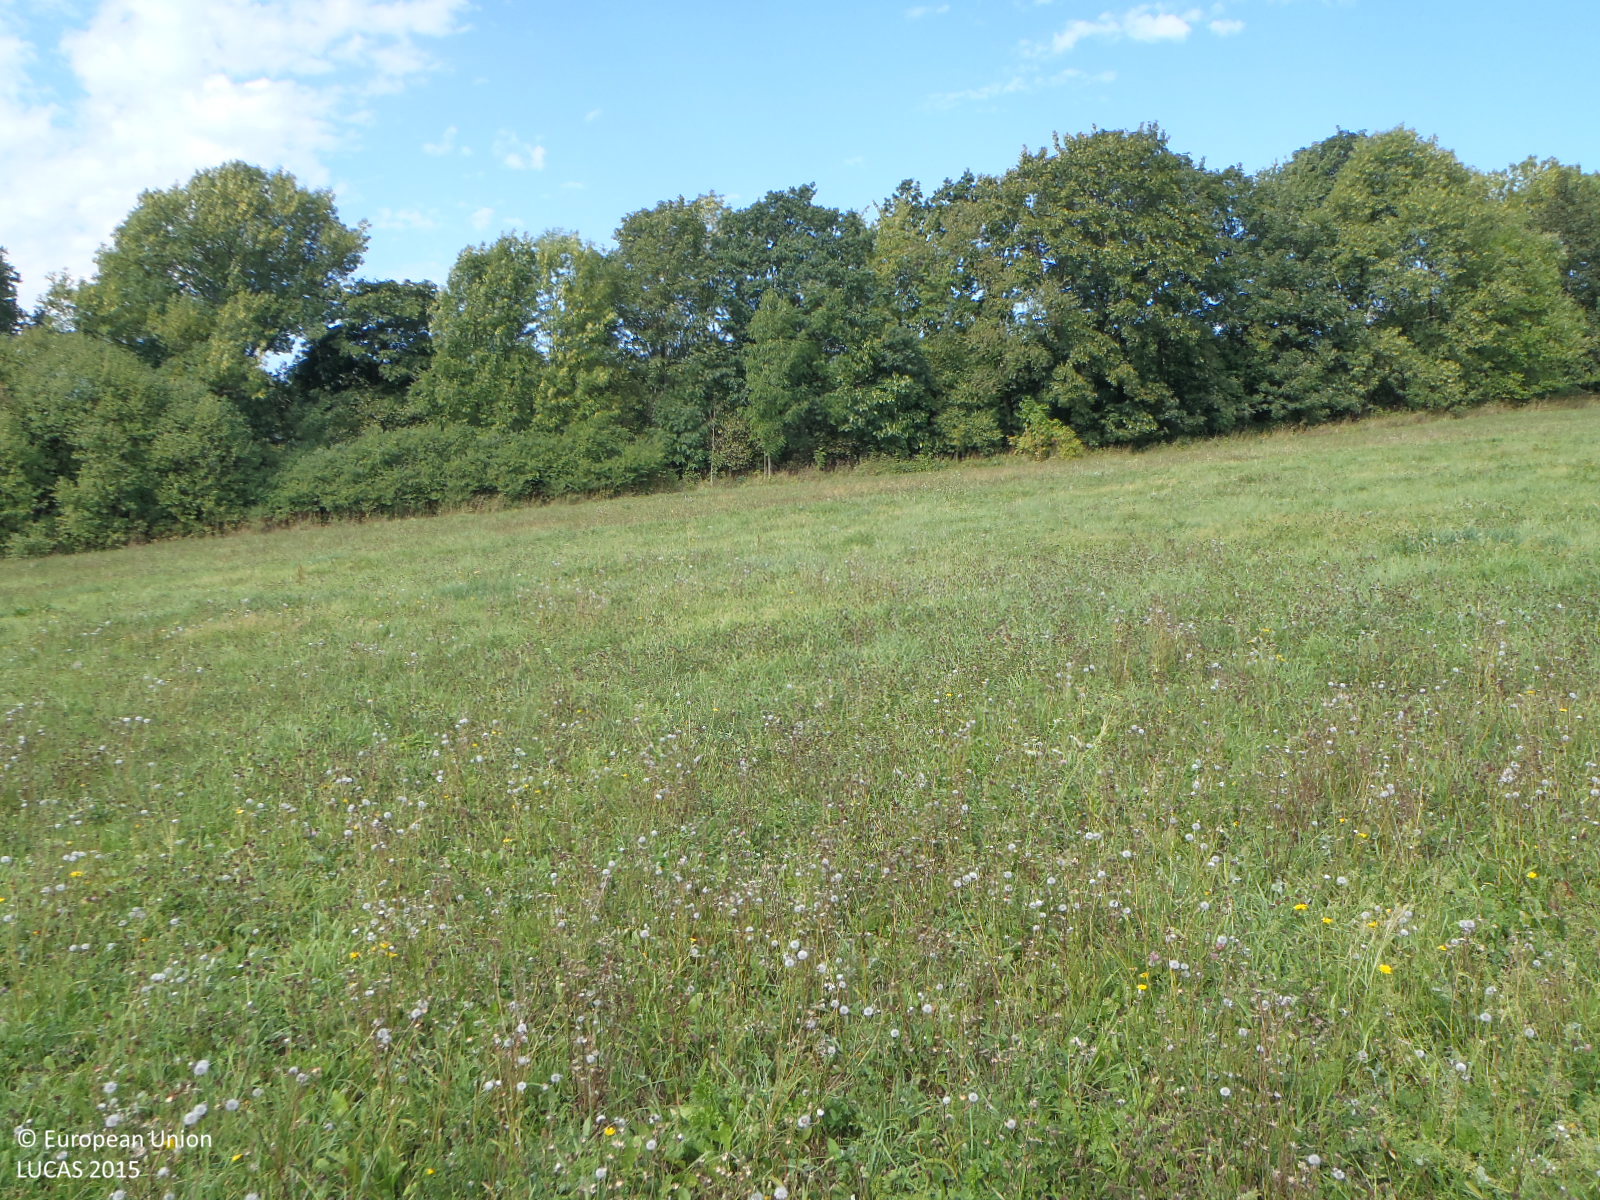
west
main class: Grassland
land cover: Grassland without tree/shrub cover
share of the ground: > 75 %
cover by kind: herbaceous plants 100 %
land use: Agriculture (excluding fallow land and kitchen gardens)
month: August
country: CZ
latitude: 50.8853
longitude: 14.5649
